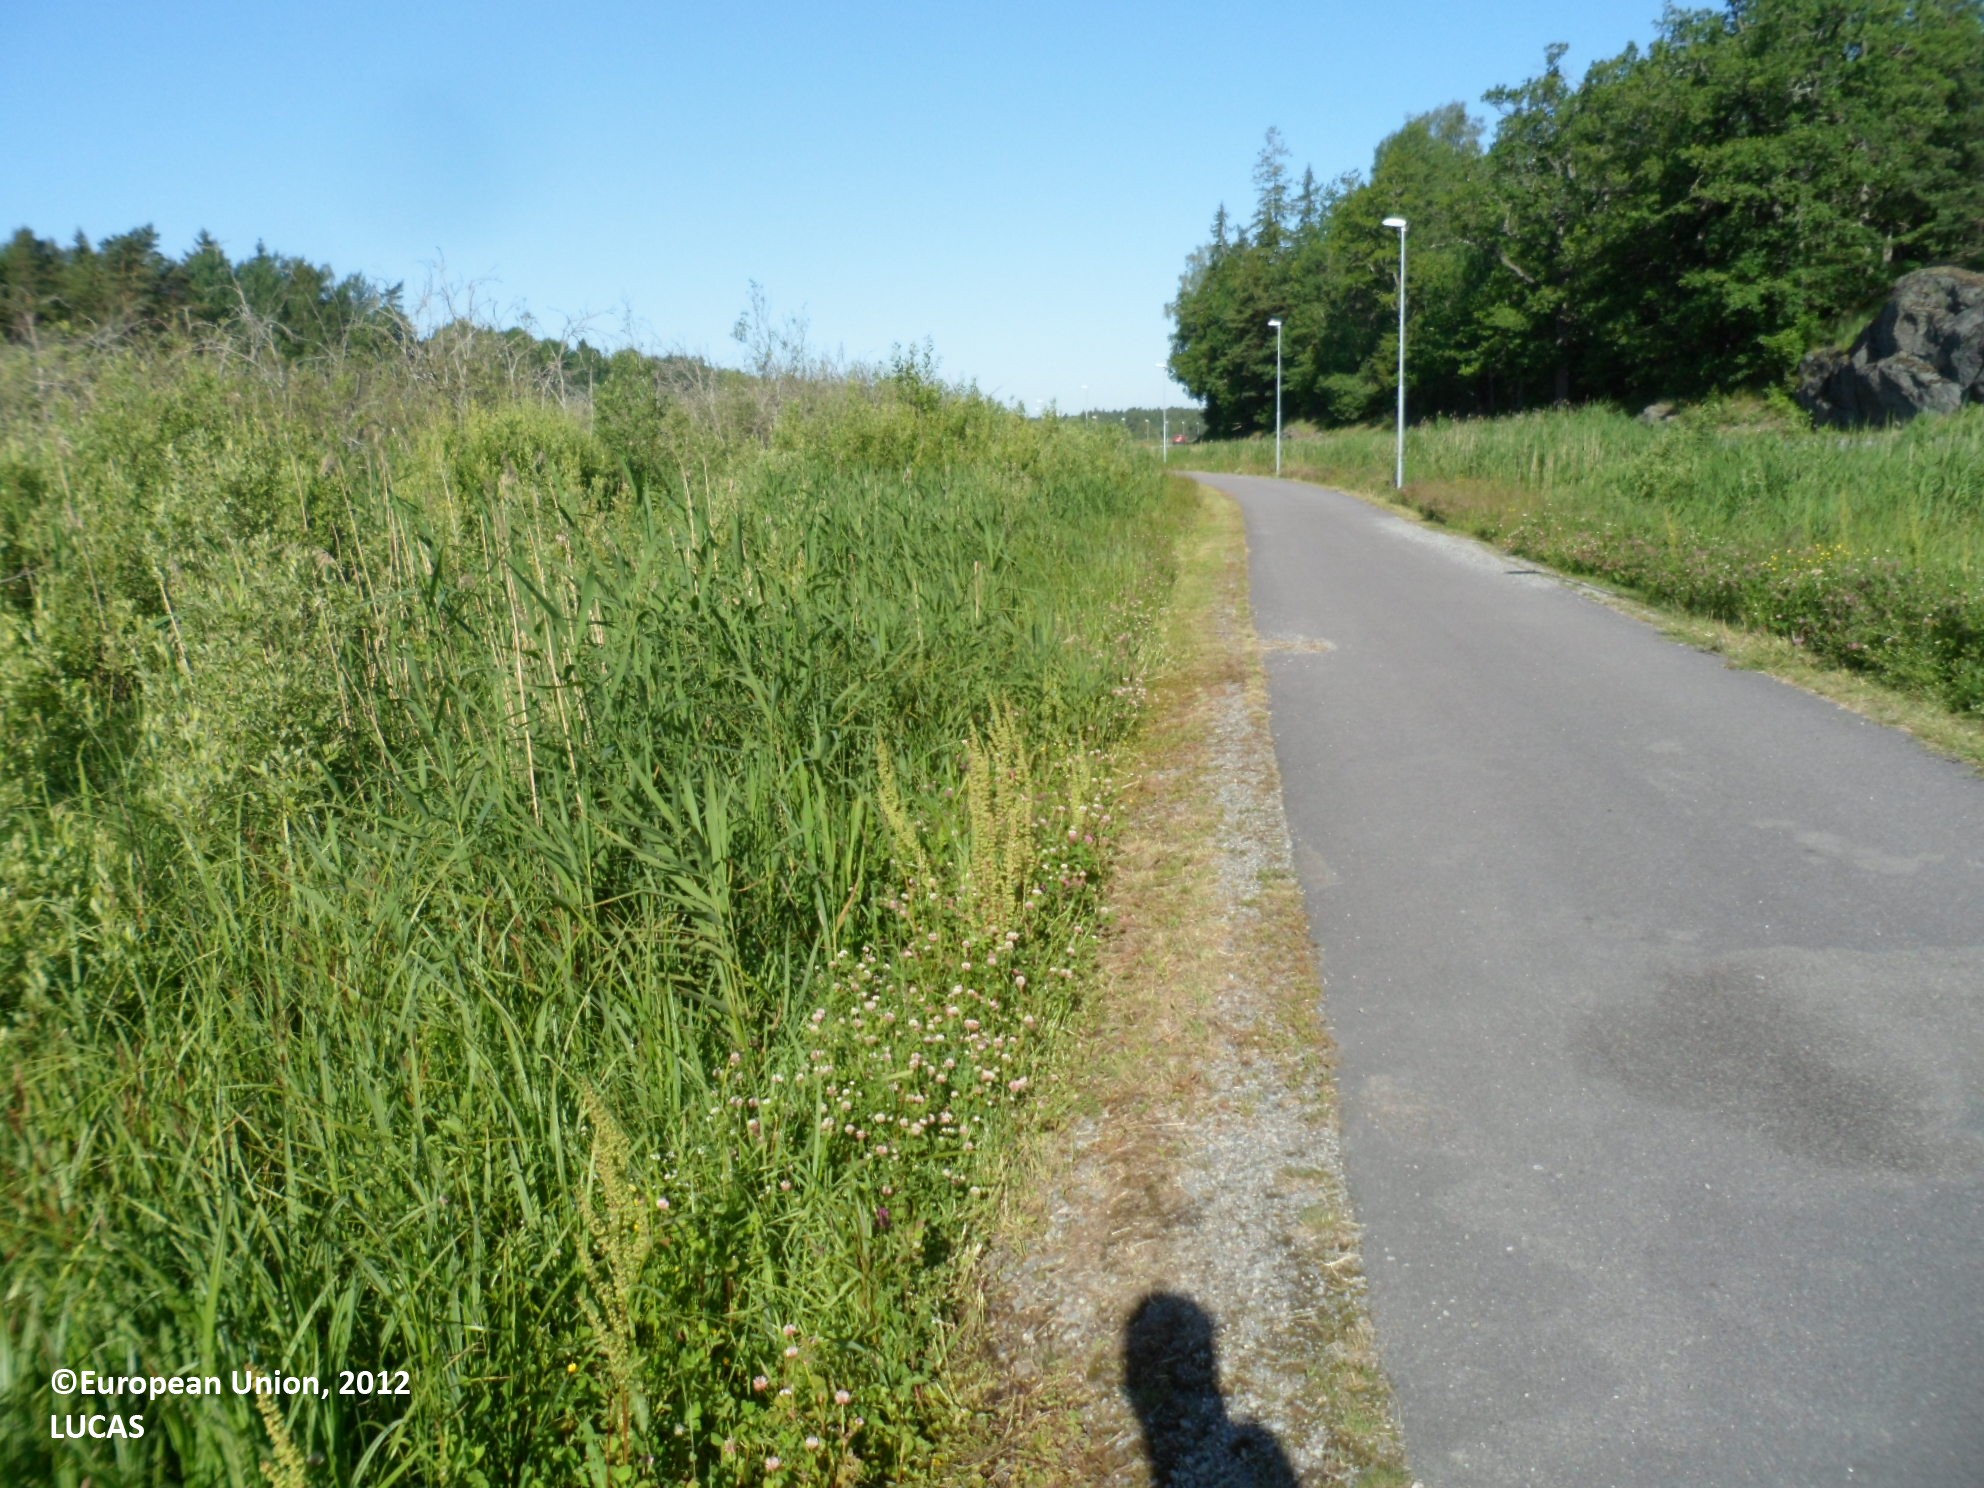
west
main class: Shrubland
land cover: Shrubland with sparse tree cover
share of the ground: > 75 %
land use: Semi-natural and natural areas not in use
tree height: > 5 m
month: July
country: SE
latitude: 59.3246
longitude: 18.5241
